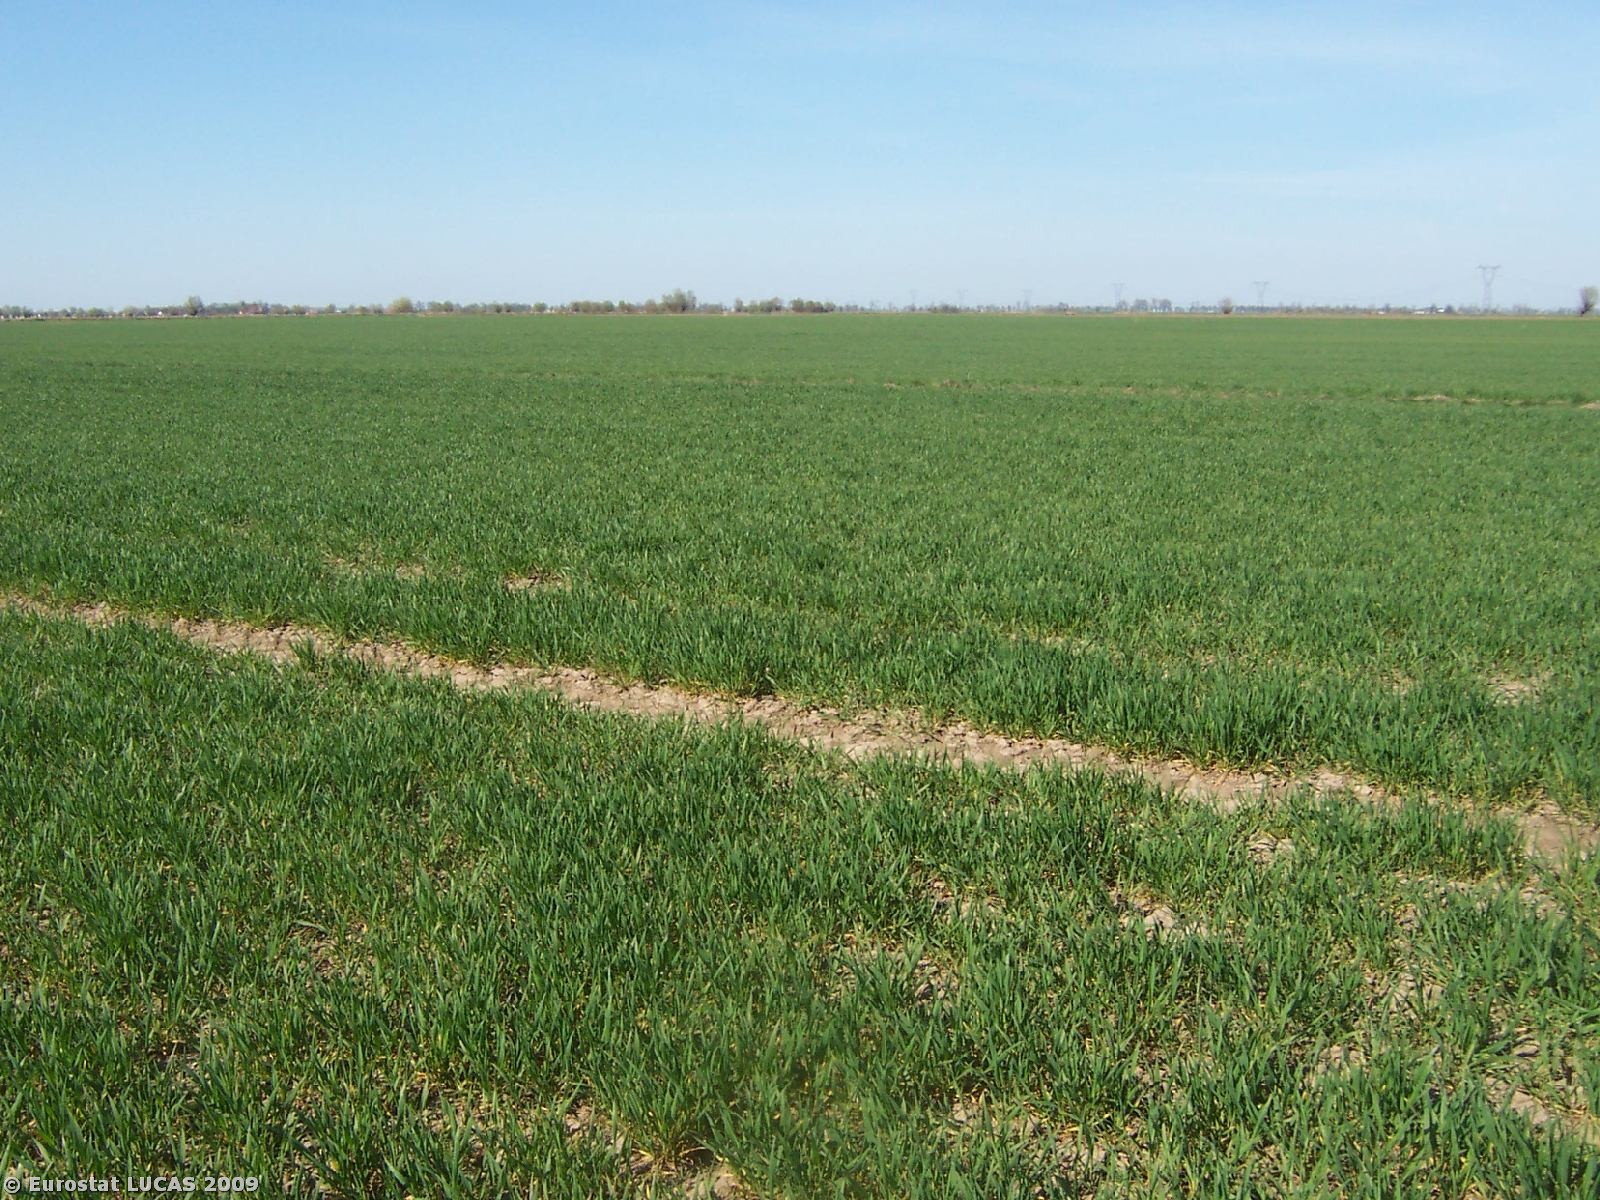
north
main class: Cropland
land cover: Common wheat
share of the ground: 25 - 50 %
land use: Agriculture (excluding fallow land and kitchen gardens)
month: April
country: PL
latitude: 54.0109
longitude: 18.9480
